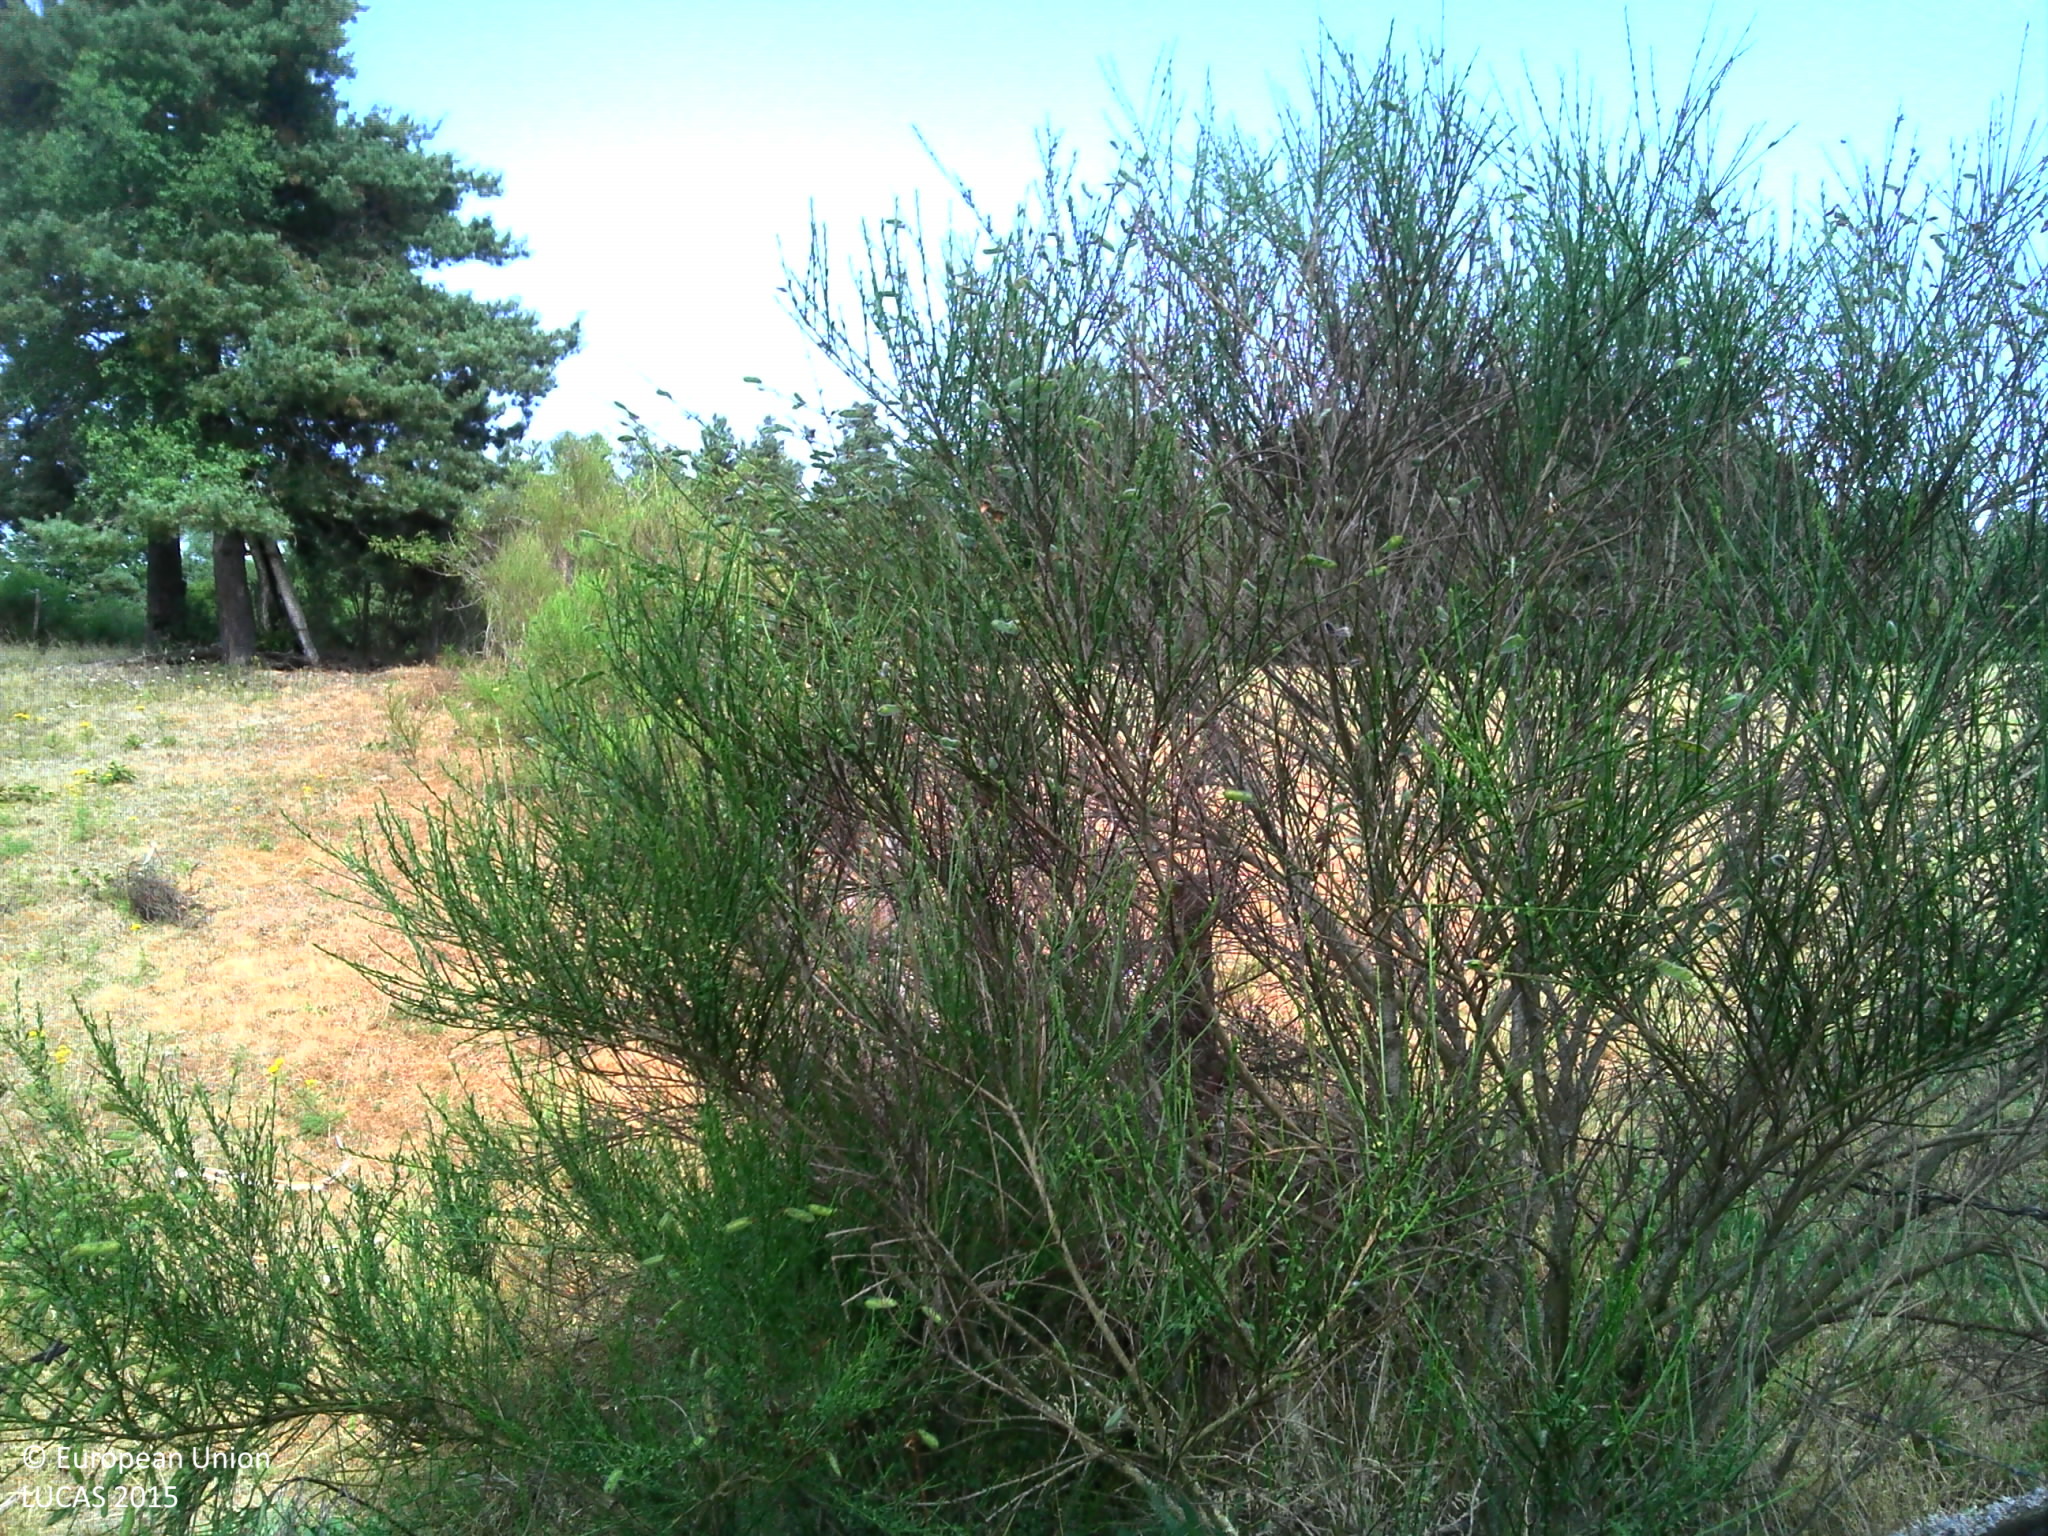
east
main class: Grassland
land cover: Grassland without tree/shrub cover
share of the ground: > 75 %
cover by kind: herbaceous plants 100 %
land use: Agriculture (excluding fallow land and kitchen gardens)
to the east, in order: Grassland without tree/shrub cover; Abandoned hedges; Fences; Grassland without tree/shrub cover; Fences; Pine dominated mixed woodland; Tracks; Pine dominated mixed woodland; Broadleaved woodland
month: July
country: FR
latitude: 44.8875
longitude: 3.2041
